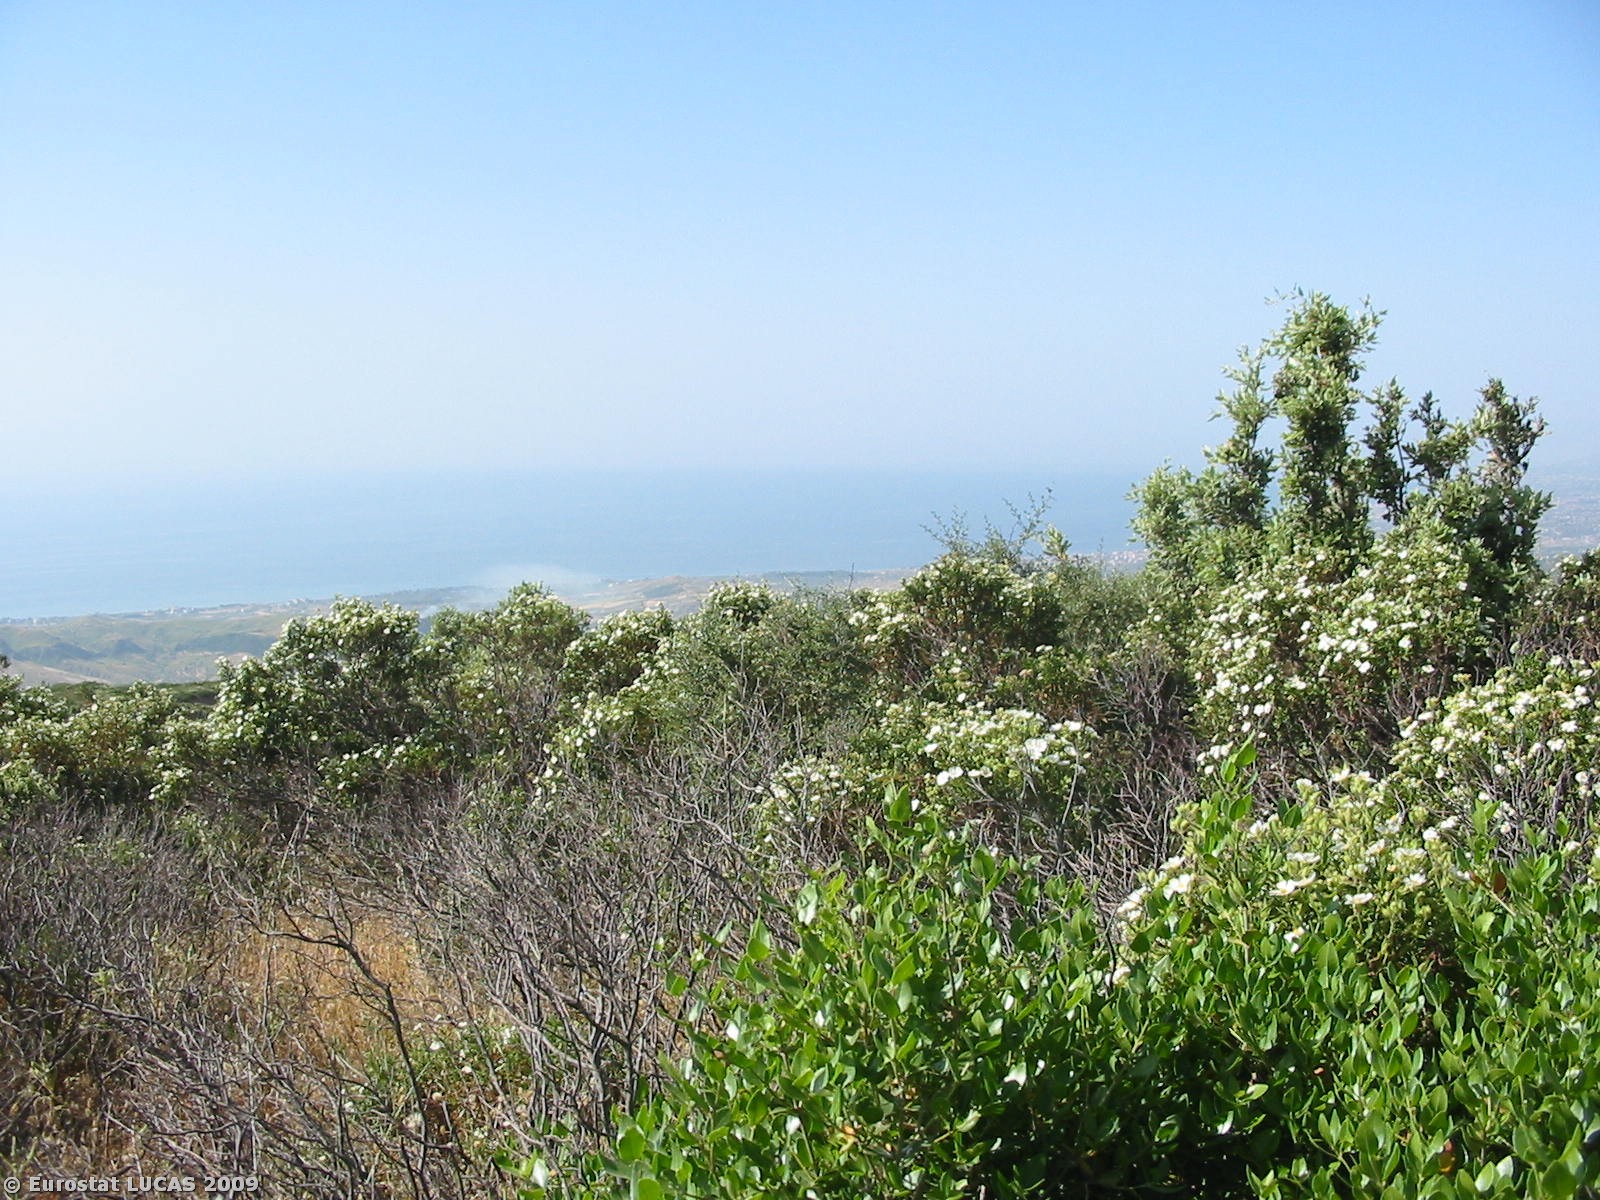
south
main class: Woodland
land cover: Broadleaved woodland
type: broadleaved evergreen forest
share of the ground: > 75 %
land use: Unused
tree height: > 5 m
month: May
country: IT
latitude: 38.3712
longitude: 16.3615
